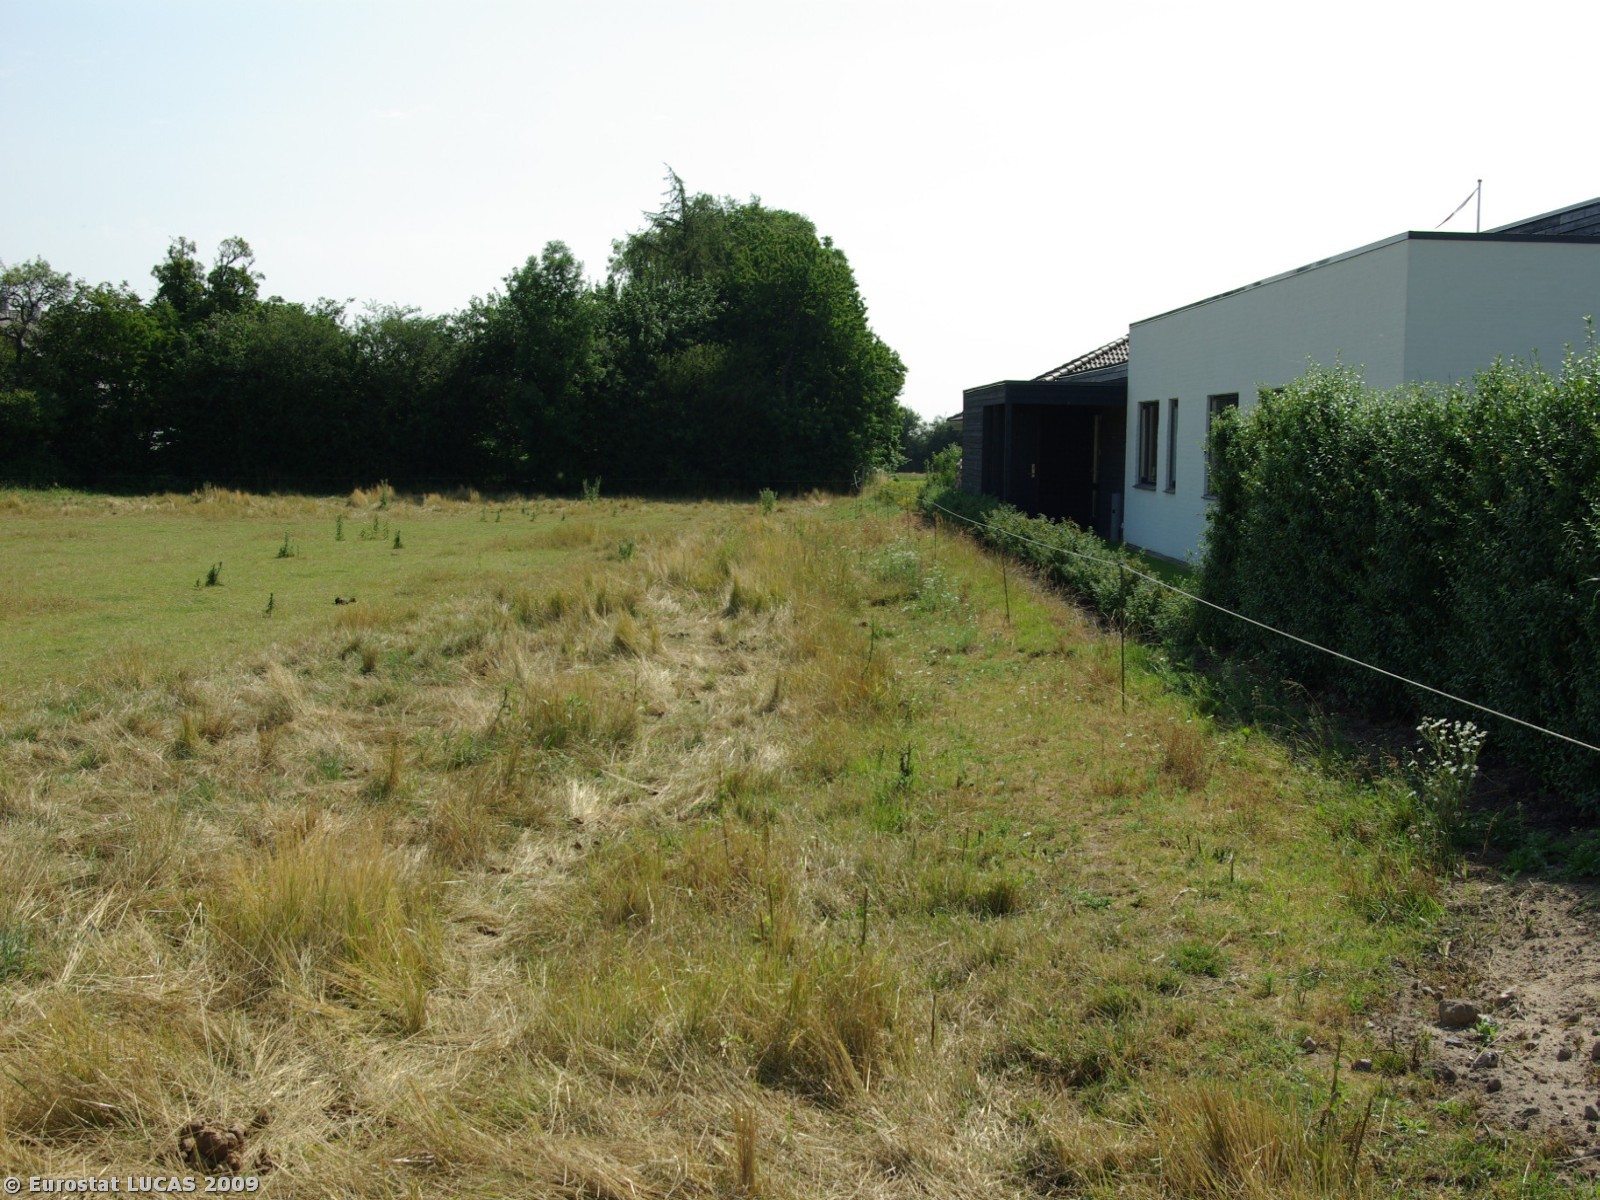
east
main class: Grassland
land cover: Grassland without tree/shrub cover
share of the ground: > 75 %
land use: Agriculture (excluding fallow land and kitchen gardens)
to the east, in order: Grassland without tree/shrub cover; Fences; Broadleaved woodland; Grassland without tree/shrub cover; Fences; Grassland without tree/shrub cover; Fences; Broadleaved woodland; Barley
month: July
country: DK
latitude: 54.9472
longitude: 9.7036
